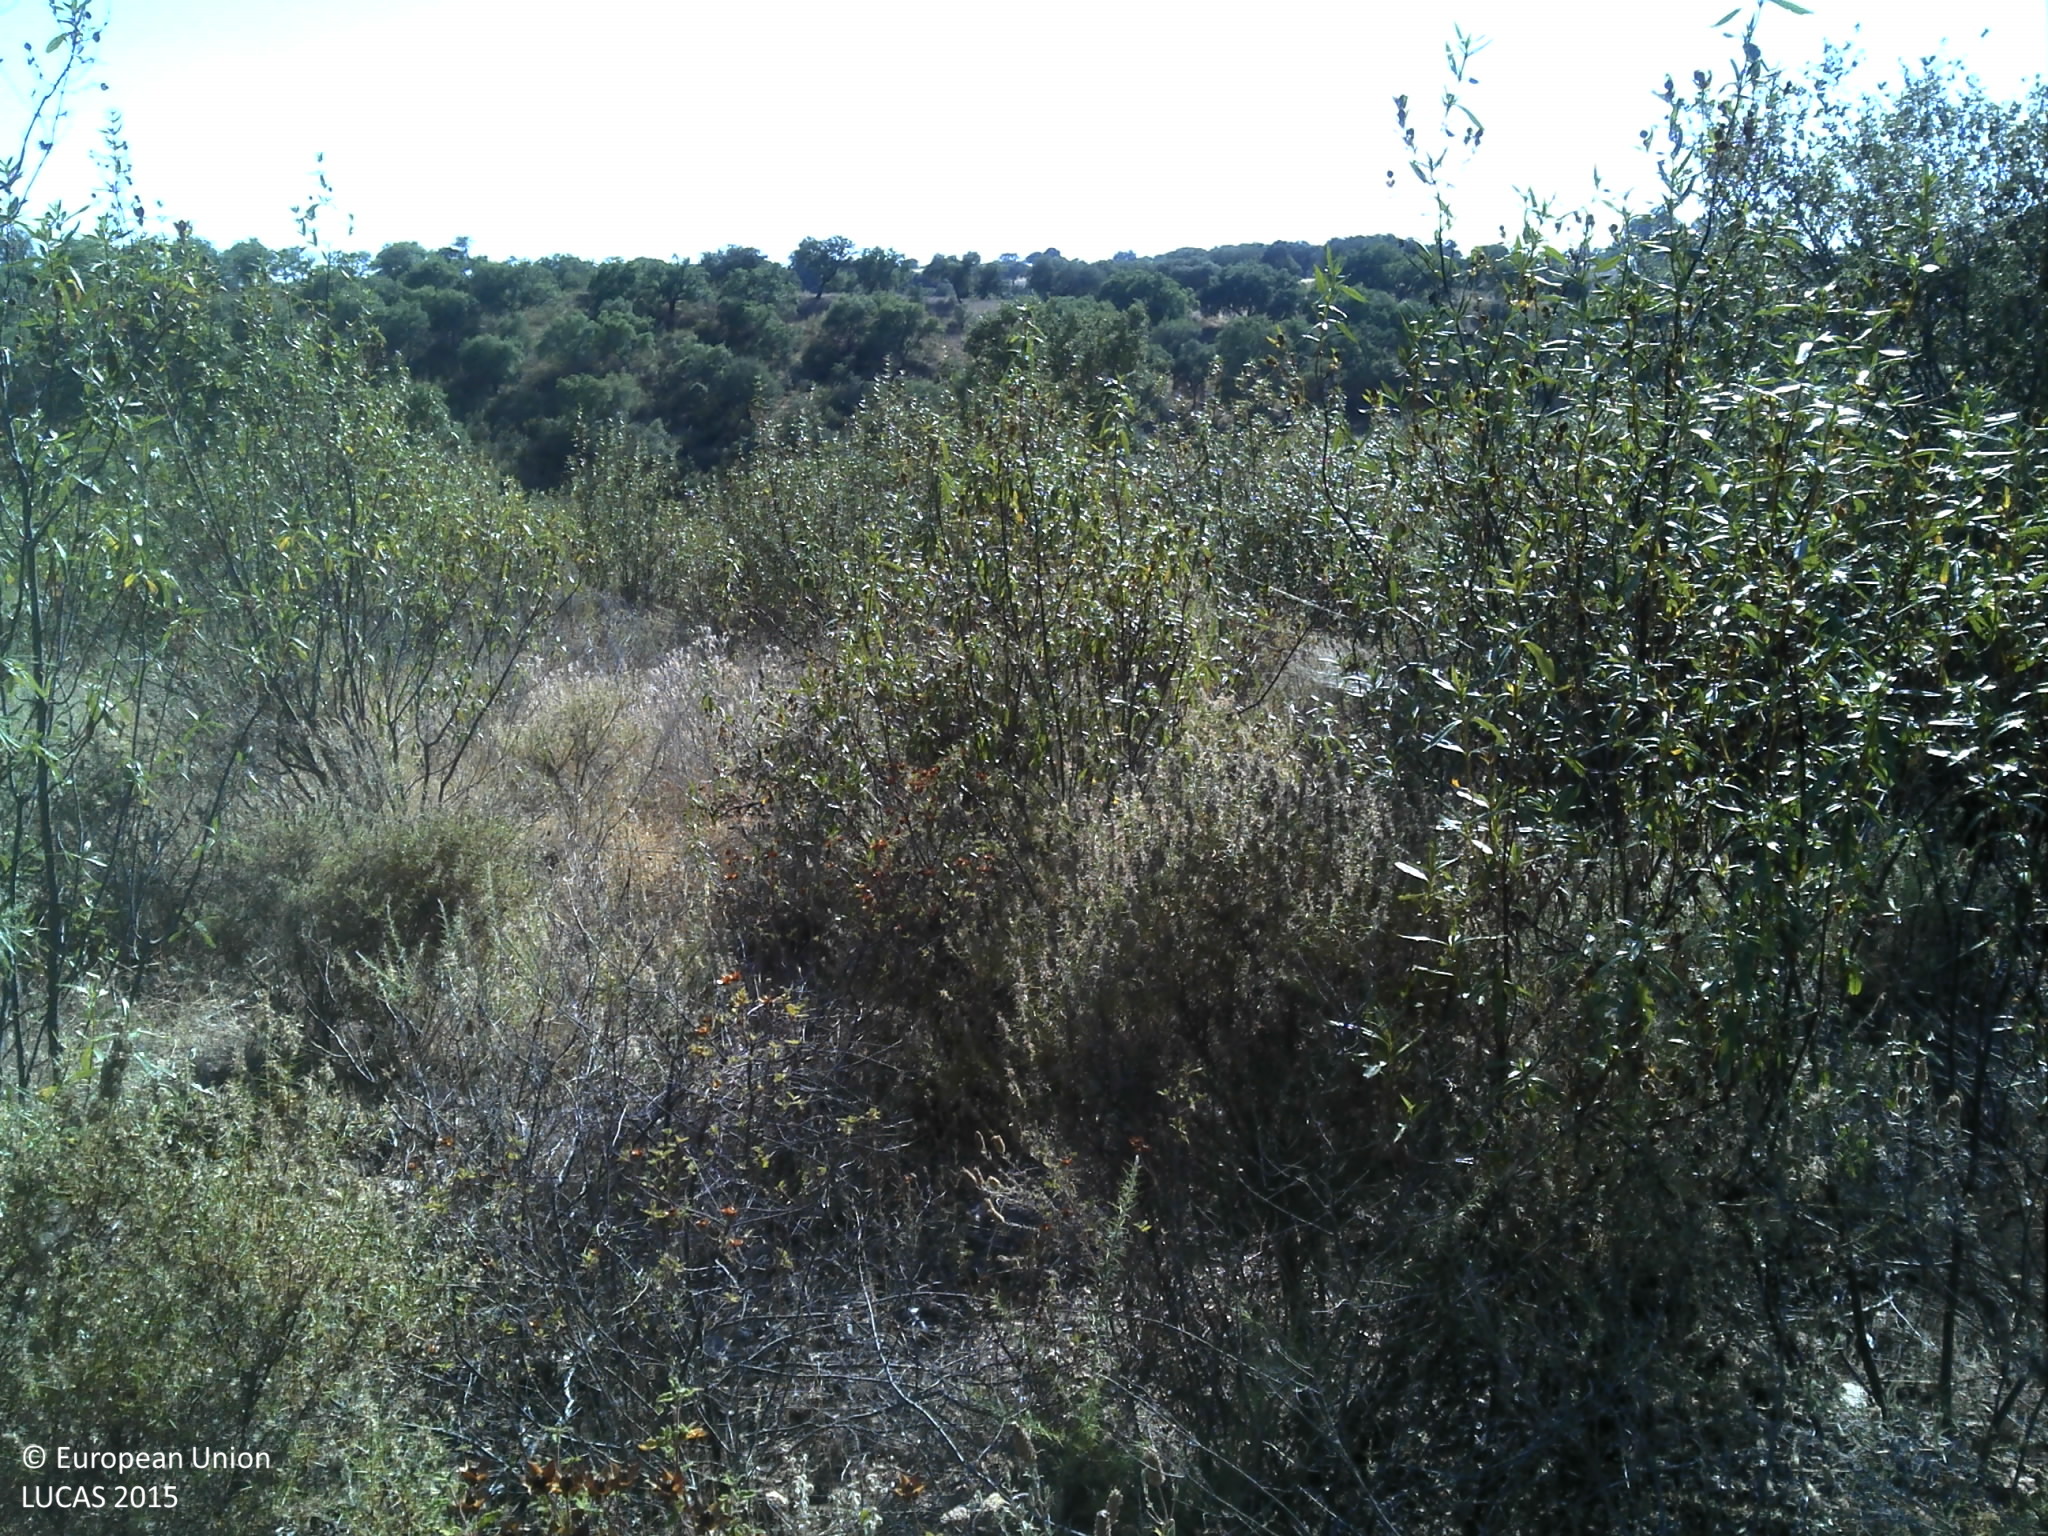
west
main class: Shrubland
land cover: Shrubland with sparse tree cover
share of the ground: > 75 %
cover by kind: shrubs 90 %, broadleaved forest trees 5 %, unconsolidated bare surface 5 %
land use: Abandoned areas
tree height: < 5 m
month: June
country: PT
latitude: 37.9068
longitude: -7.2892
